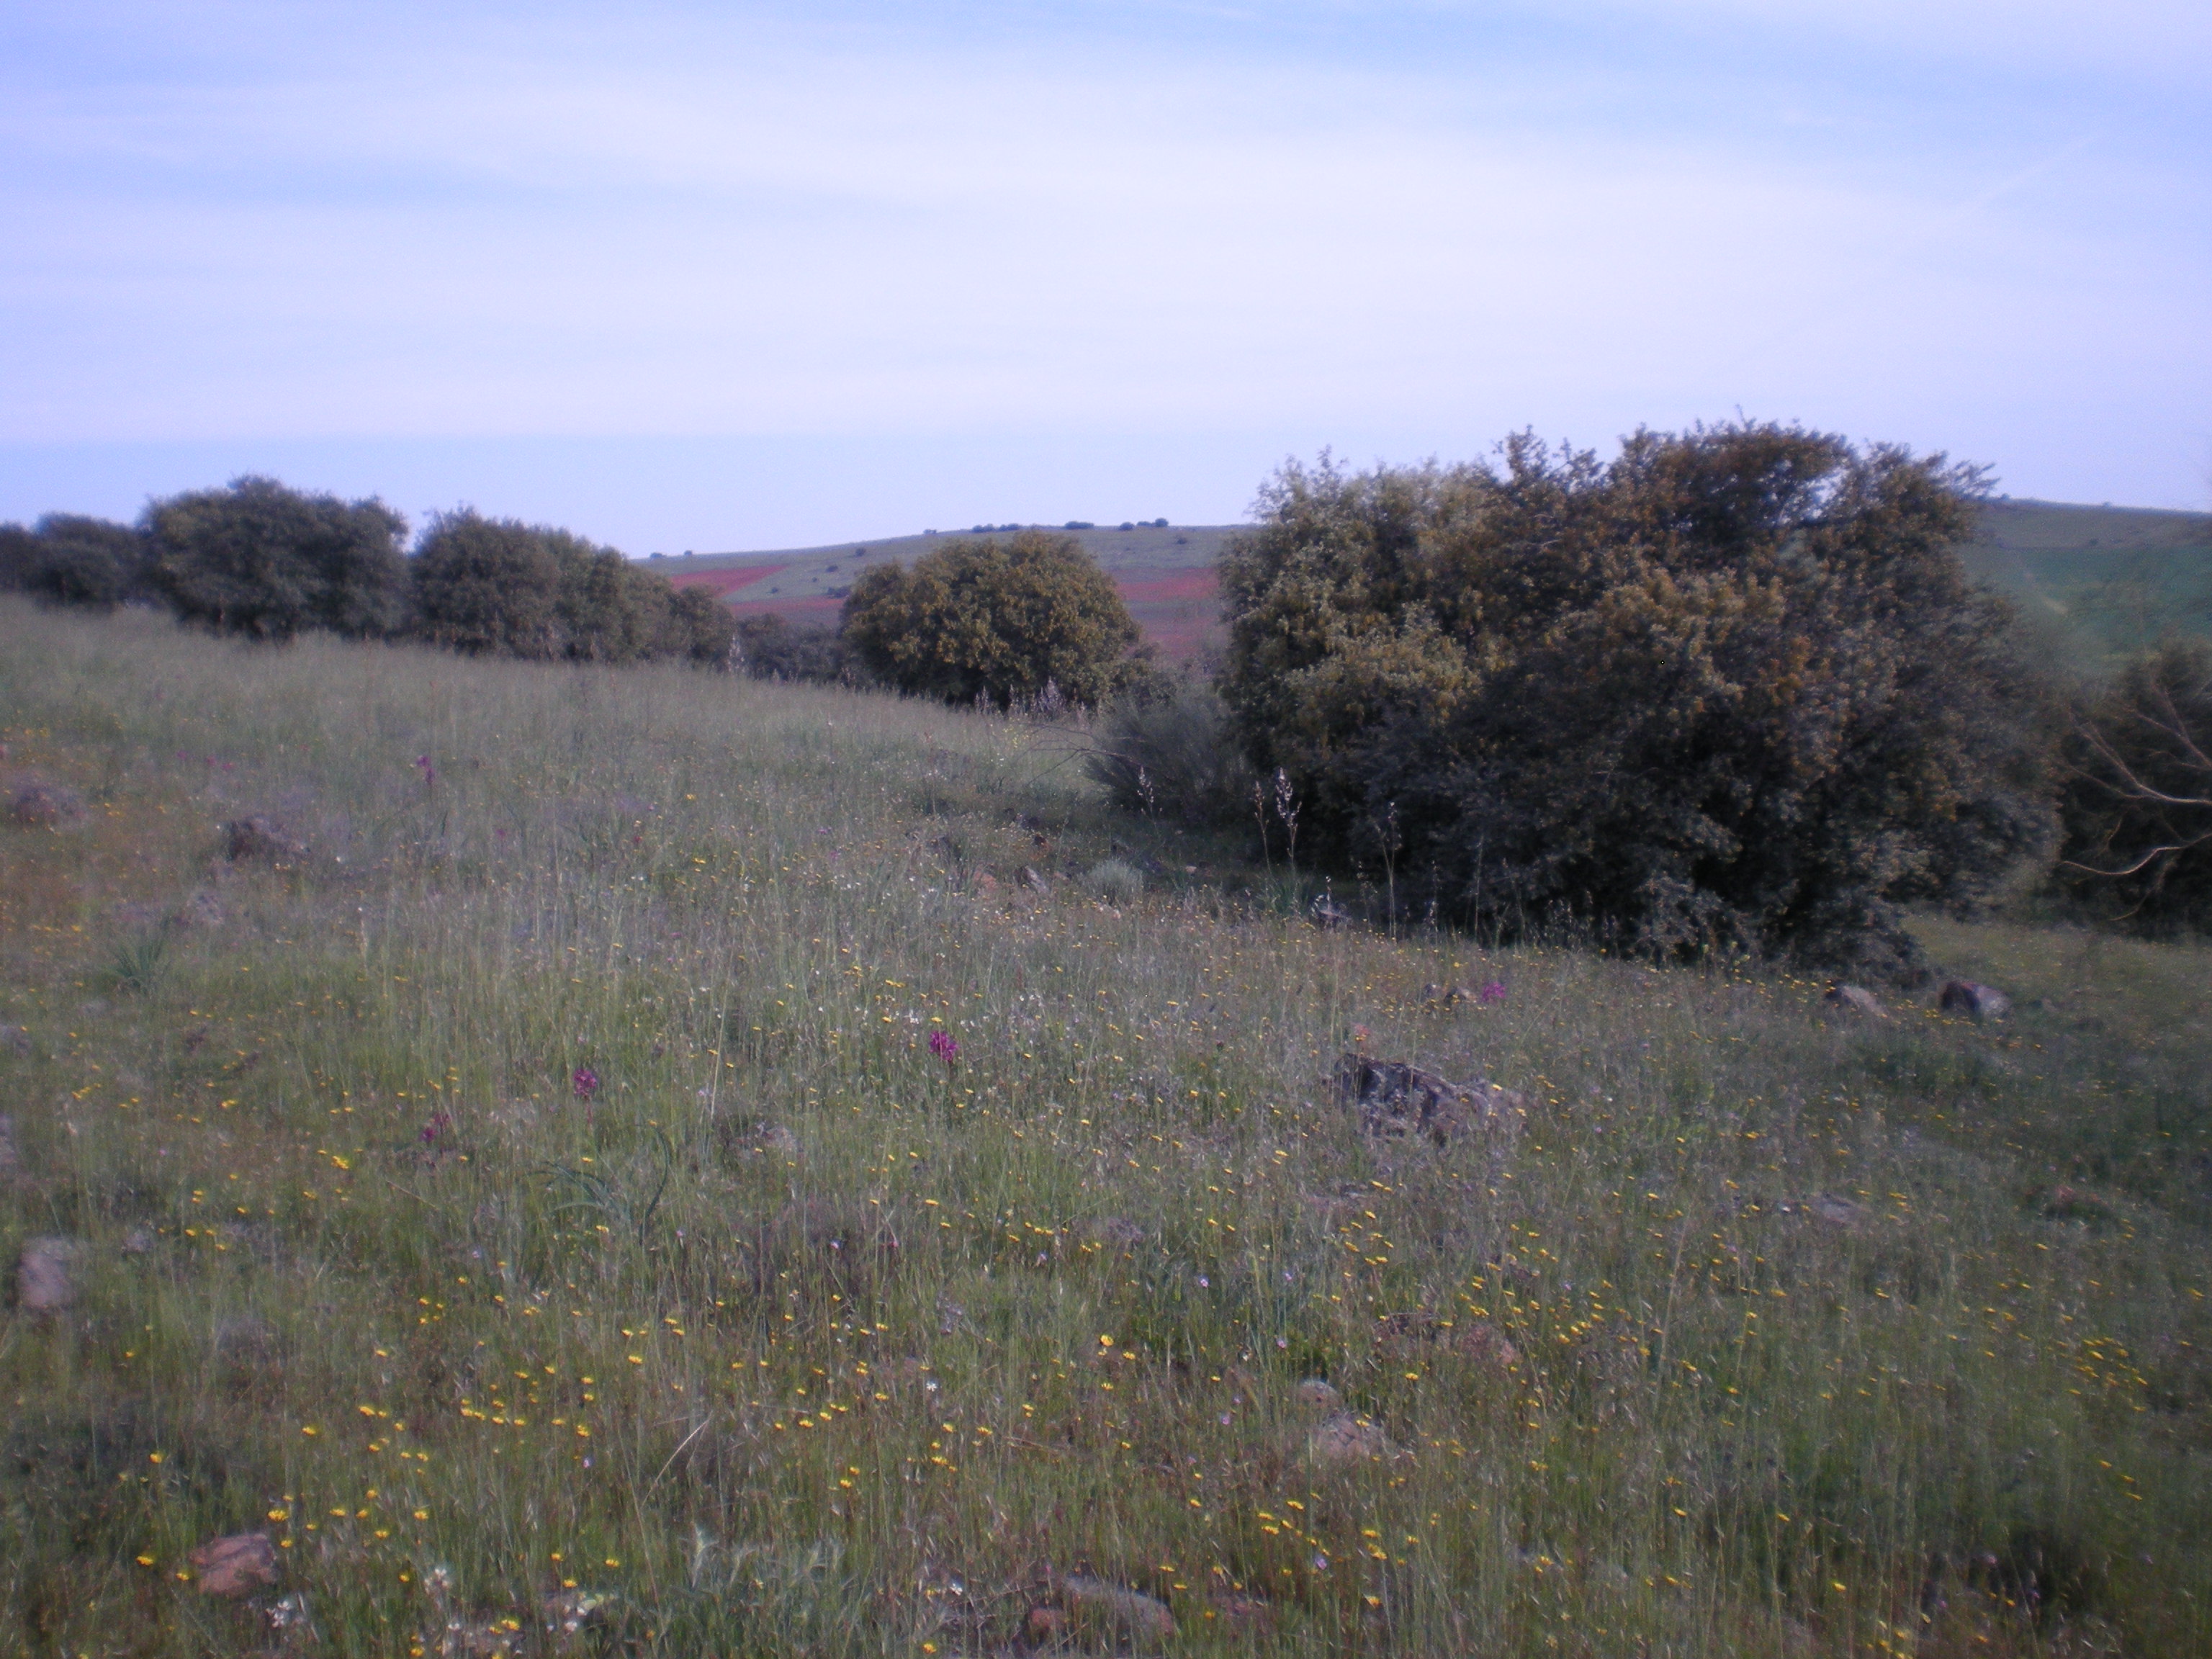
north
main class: Grassland
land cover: Grassland with sparse tree/shrub cover
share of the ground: > 75 %
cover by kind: herbaceous plants 80 %, consolidated bare surface 15 %, broadleaved forest trees 5 %
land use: Agriculture (excluding fallow land and kitchen gardens)
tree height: < 5 m
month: April
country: ES
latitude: 38.7243
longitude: -3.5038
